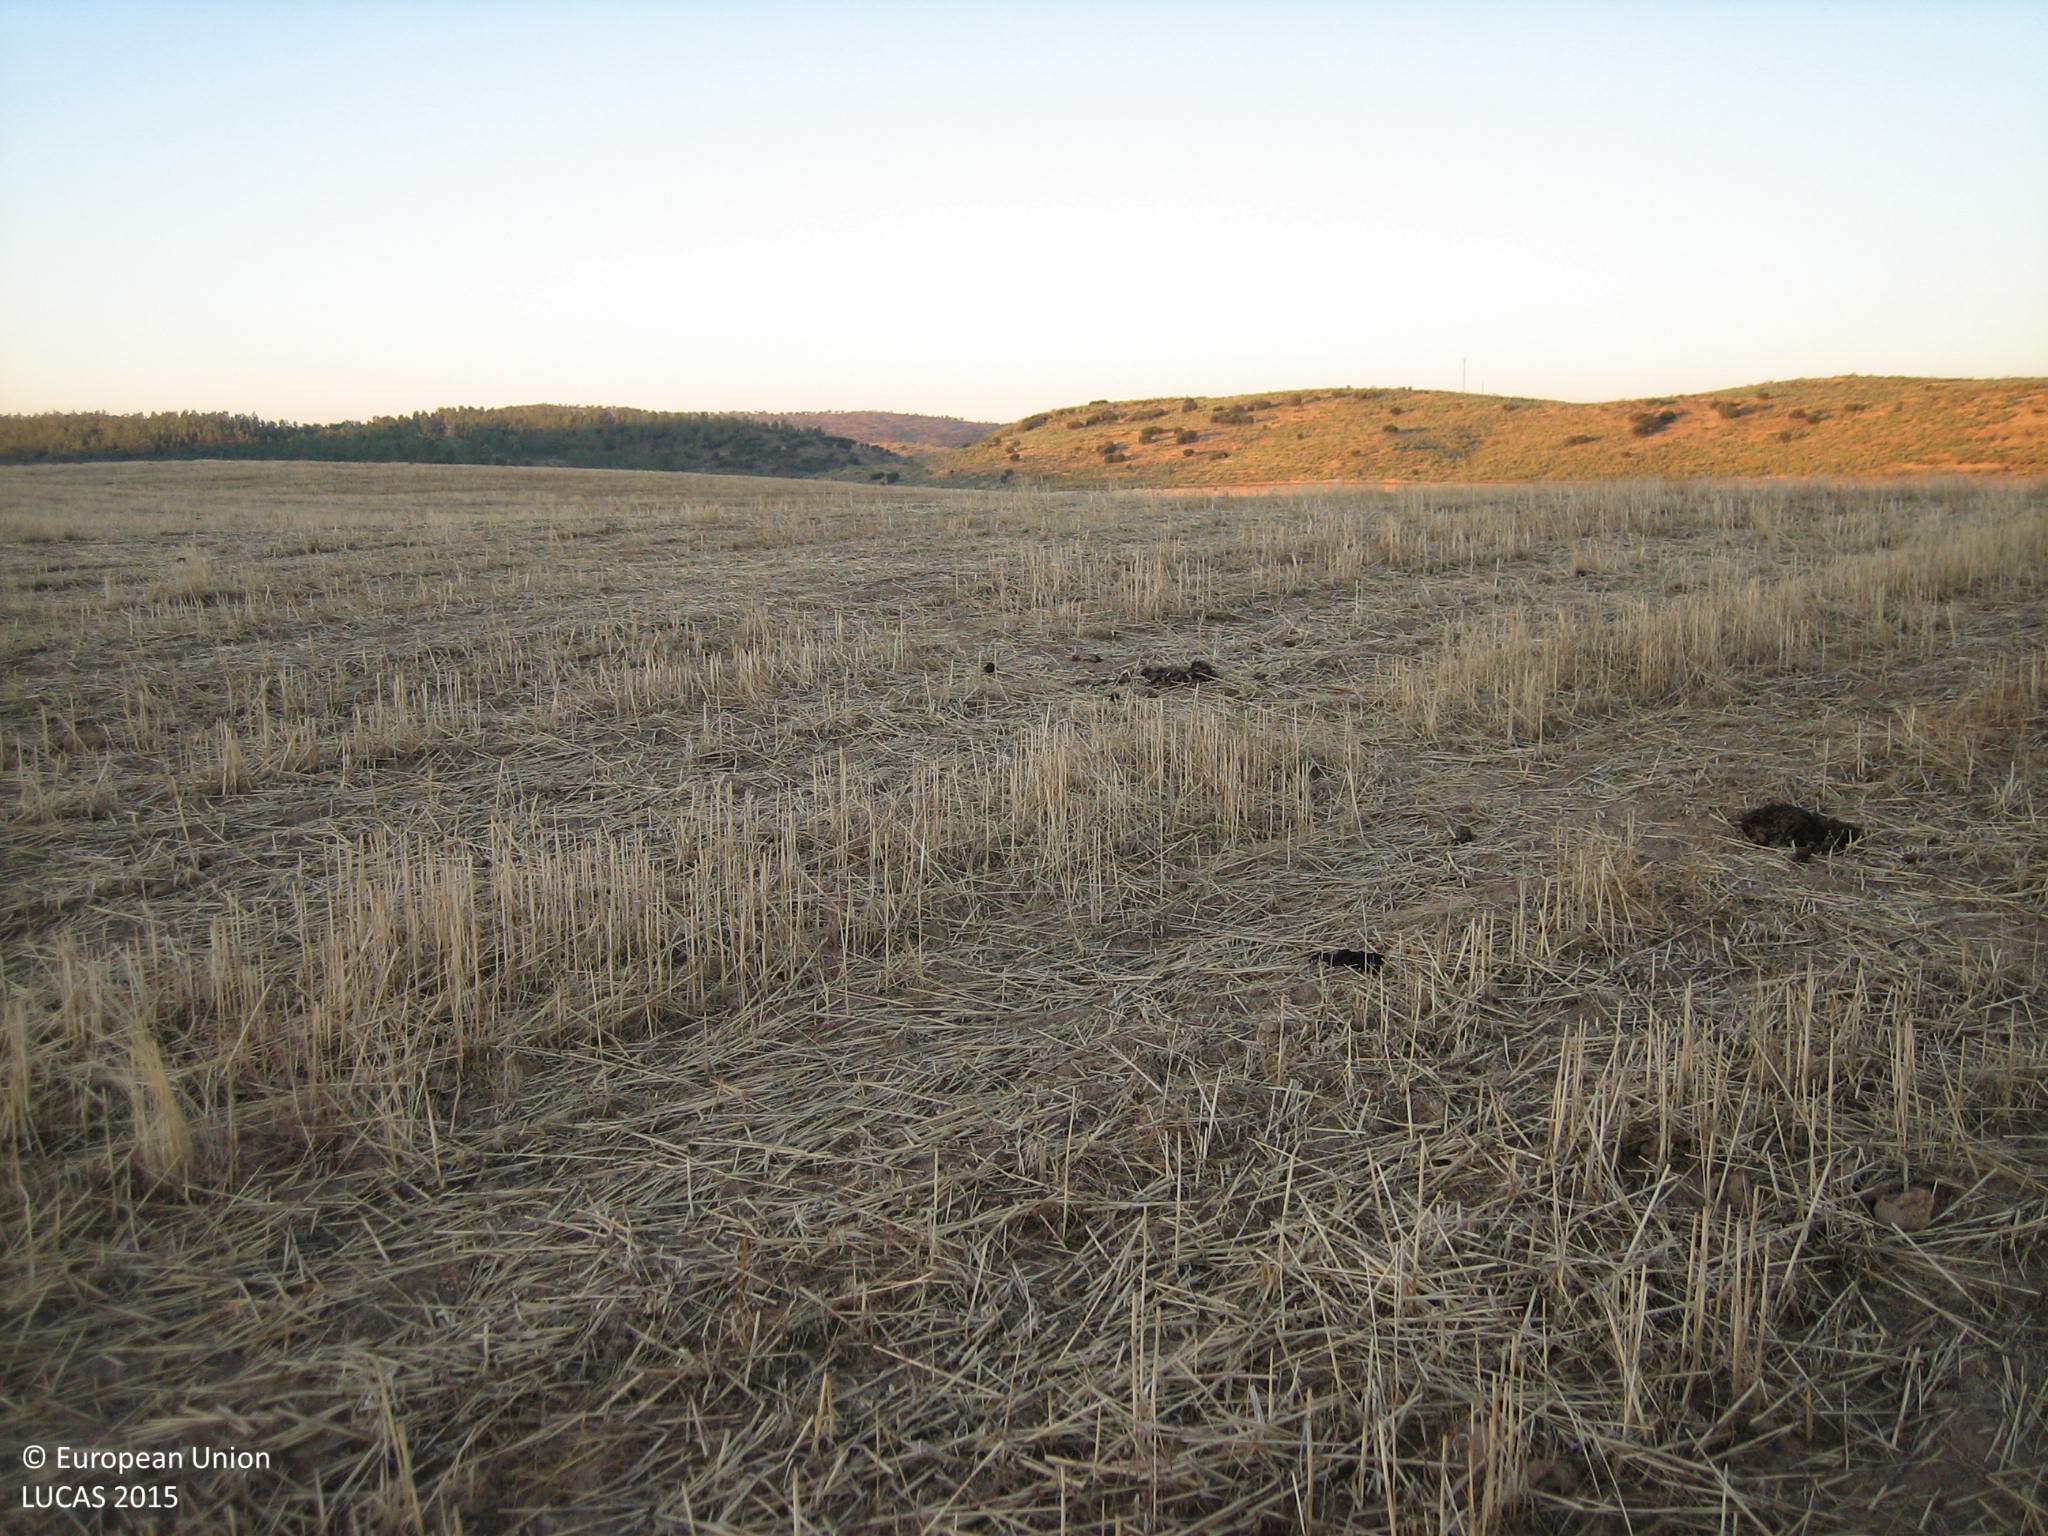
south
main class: Cropland
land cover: Common wheat
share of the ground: < 10 %
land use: Agriculture (excluding fallow land and kitchen gardens)
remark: Harvested field
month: July
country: ES
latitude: 38.2649
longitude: -6.0997
